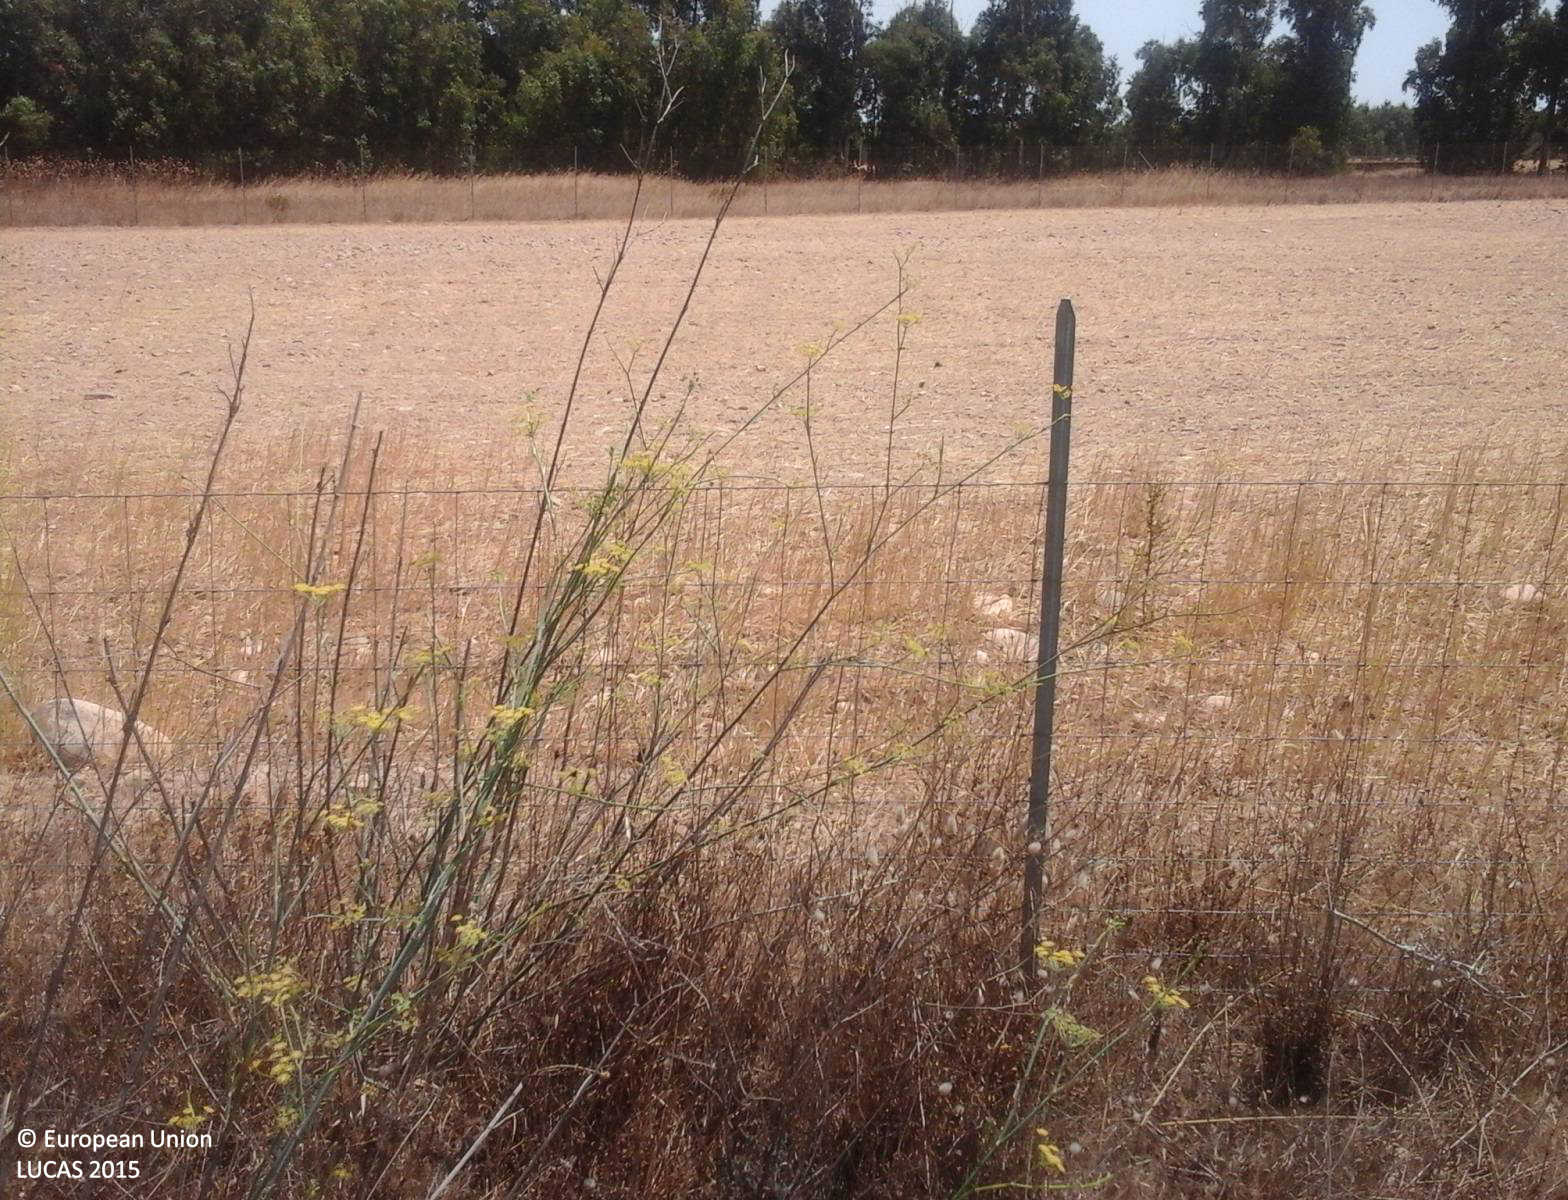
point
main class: Cropland
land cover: Temporary grasslands
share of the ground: > 75 %
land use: Agriculture (excluding fallow land and kitchen gardens)
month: August
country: IT
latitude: 39.4094
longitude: 8.8571
